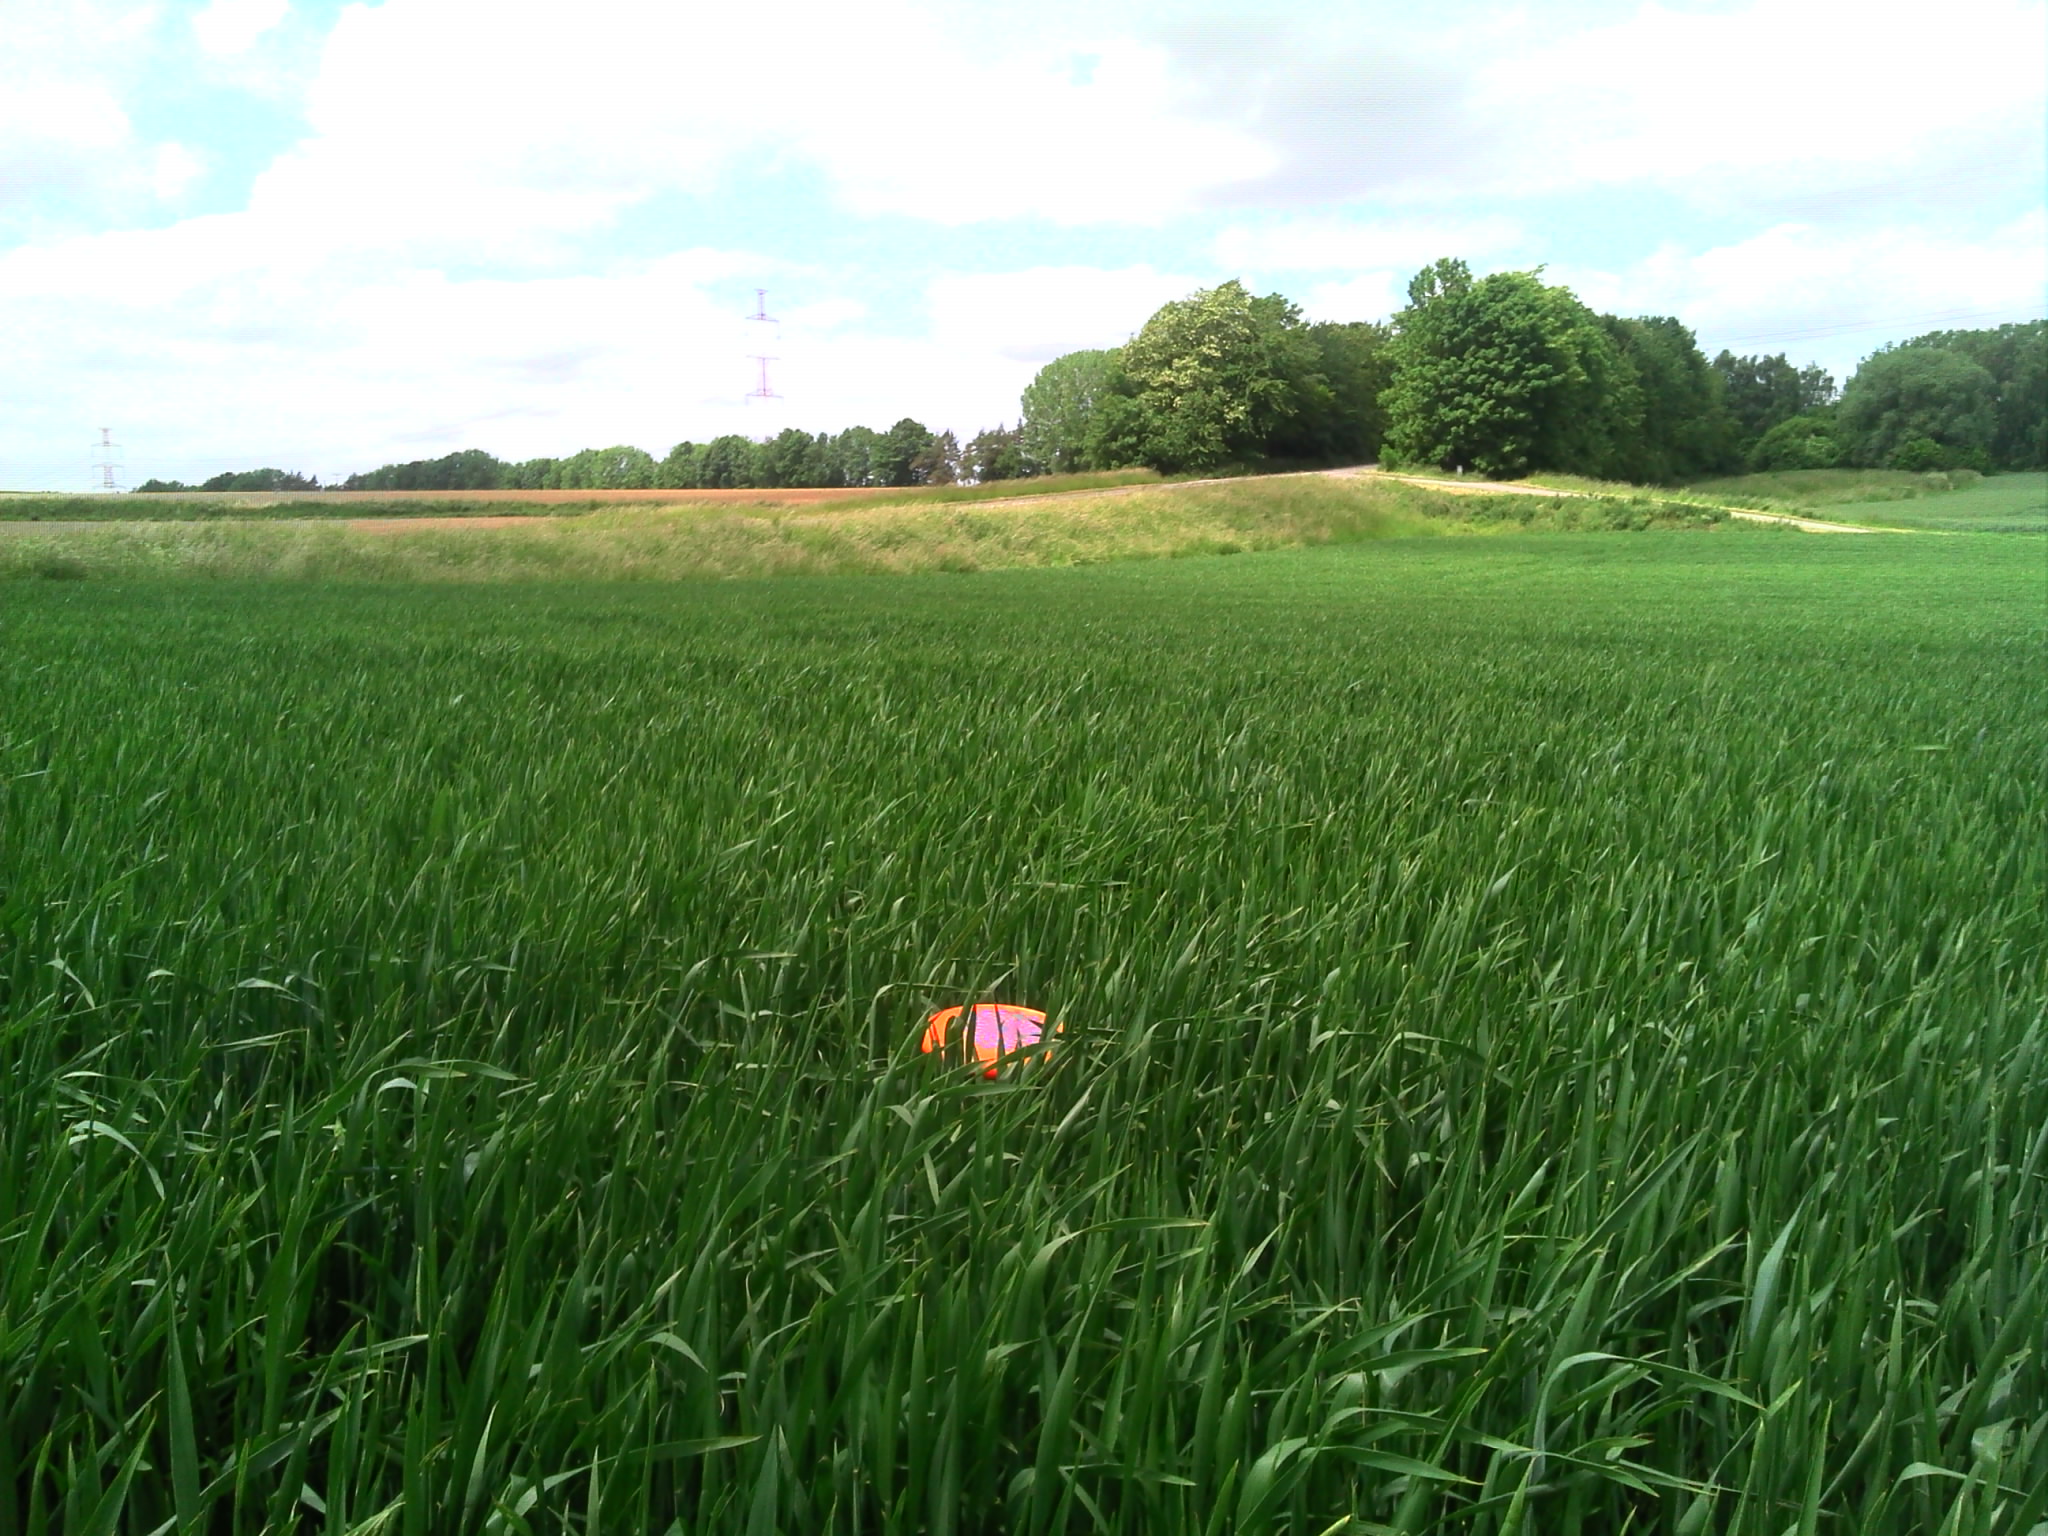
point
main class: Cropland
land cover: Common wheat
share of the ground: > 75 %
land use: Agriculture (excluding fallow land and kitchen gardens)
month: June
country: BE
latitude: 50.4914
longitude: 4.6540
